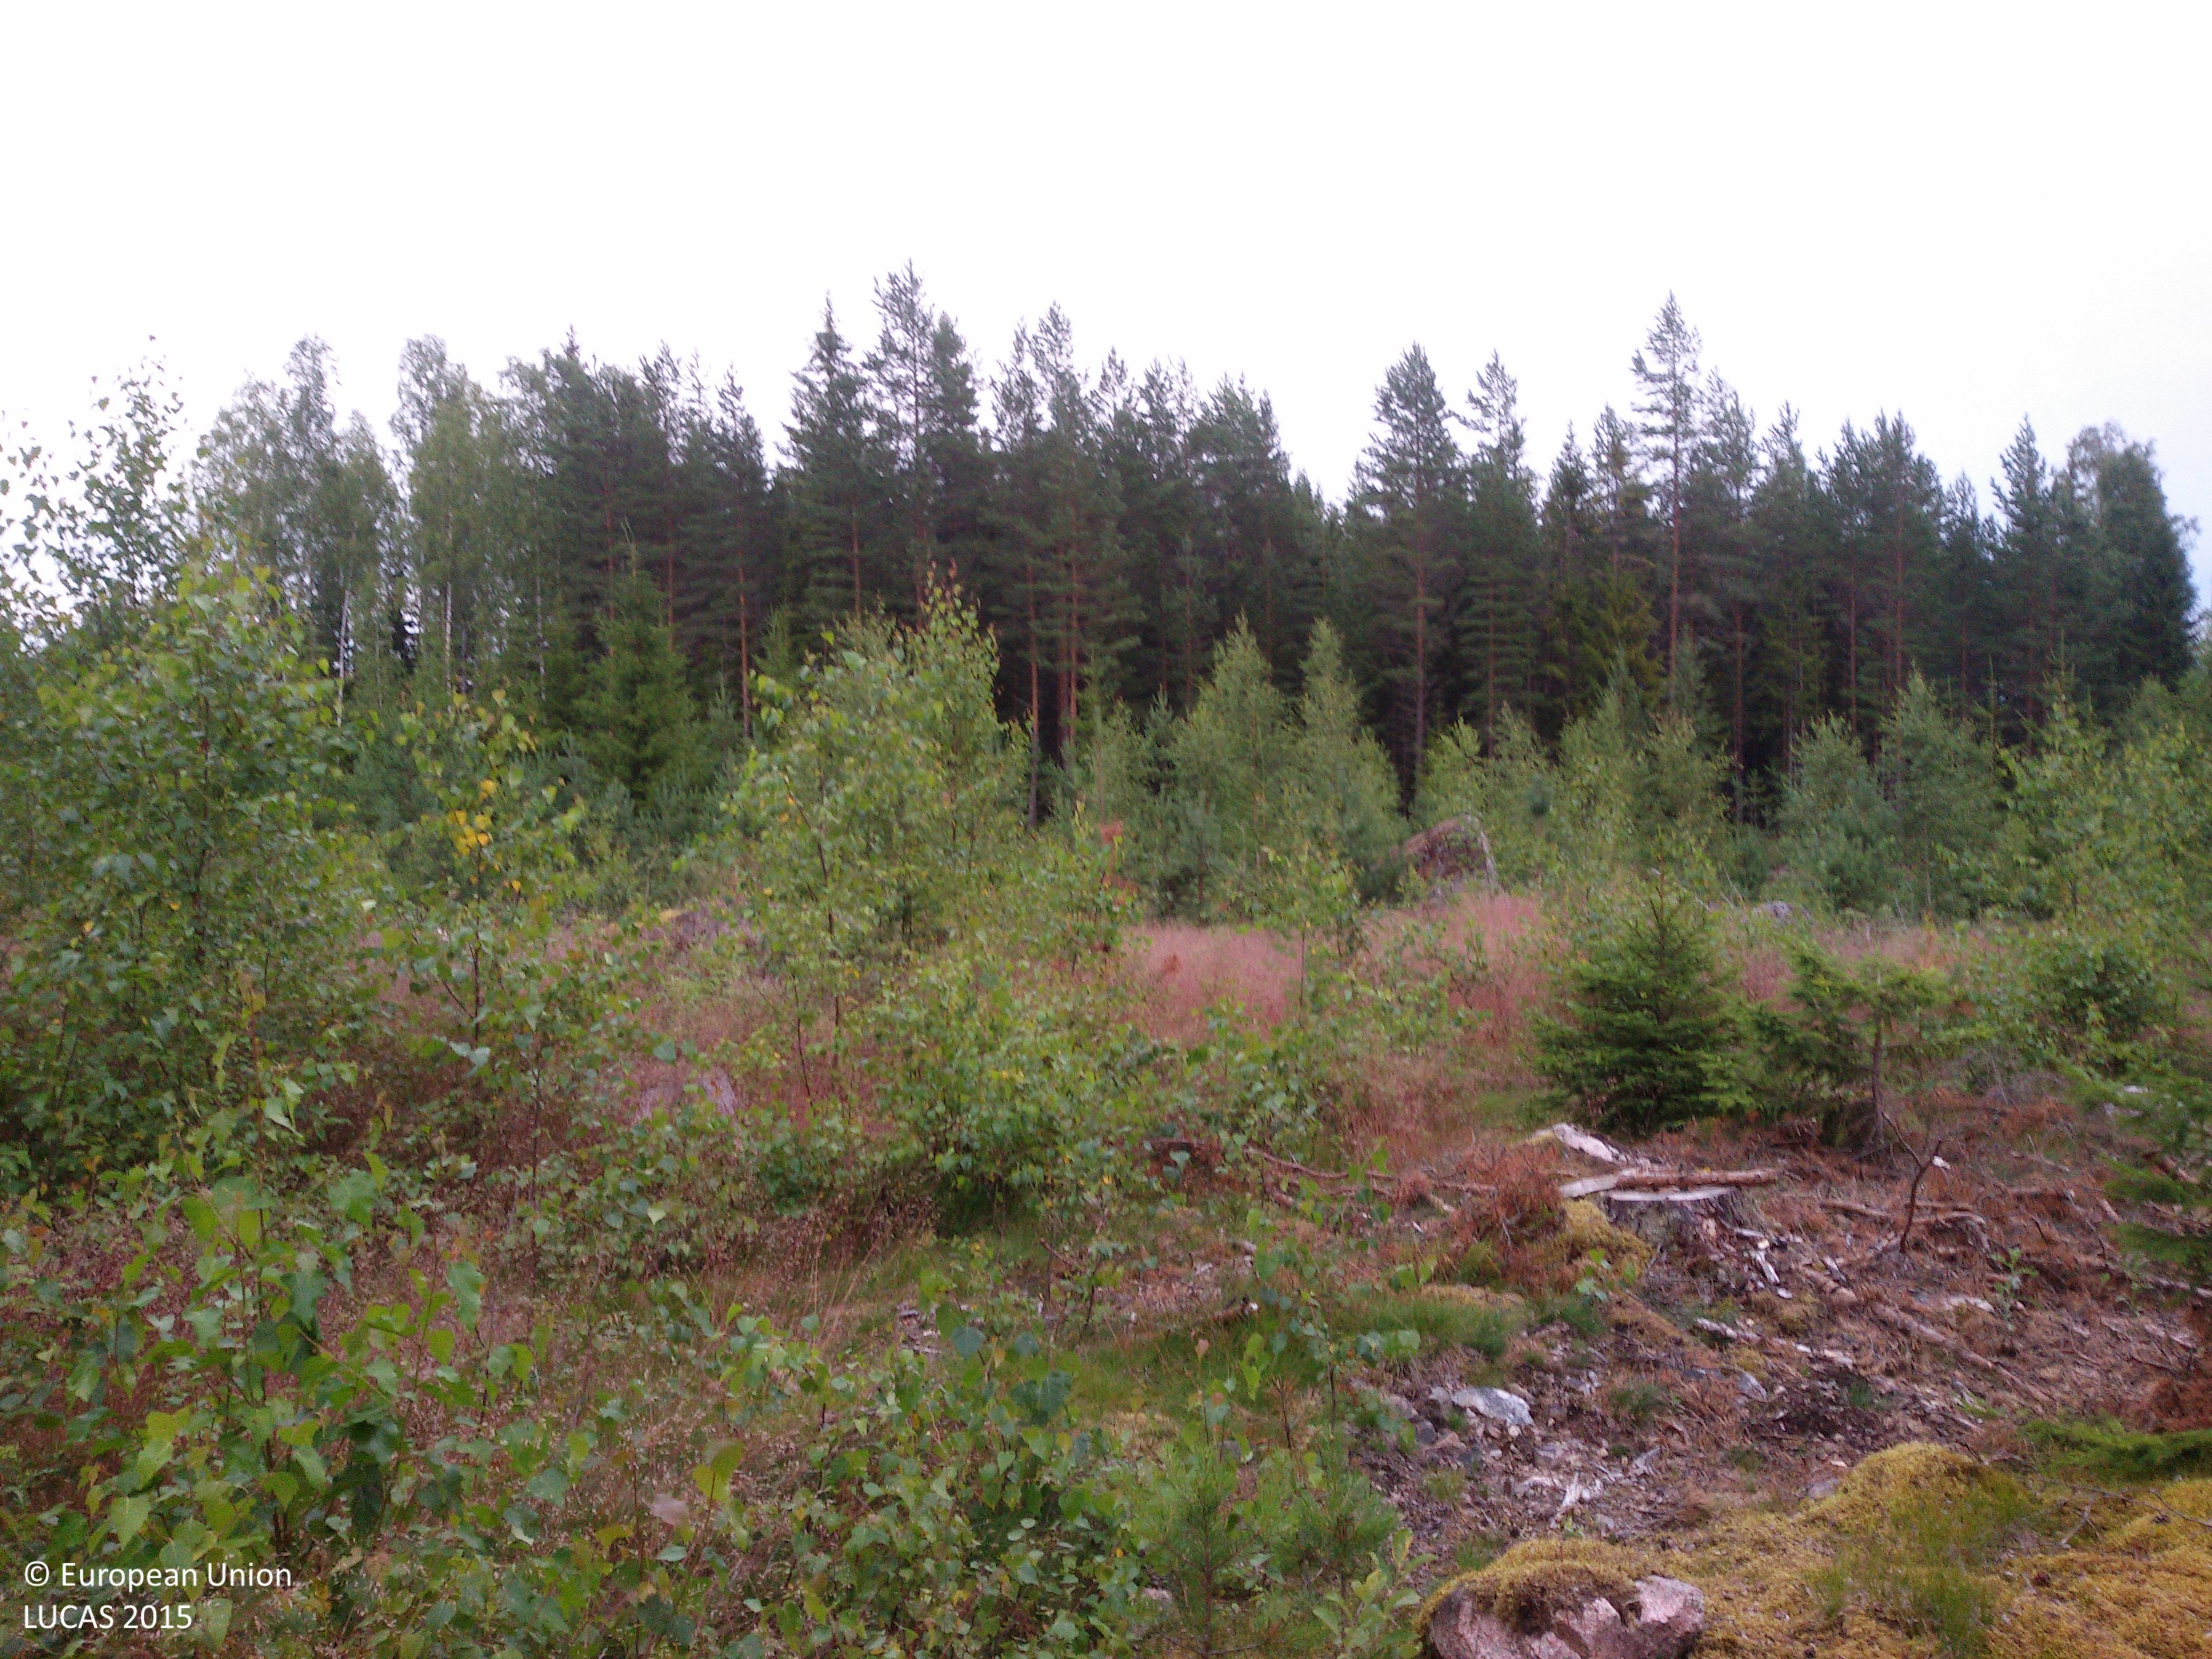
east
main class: Woodland
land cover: Spruce dominated mixed woodland
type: boreal forest
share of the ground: 50 - 75 %
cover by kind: coniferous forest trees 30 %, broadleaved forest trees 30 %, herbaceous plants 20 %, lichens and mosses 20 %
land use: Forestry
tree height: < 5 m
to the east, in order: Spruce dominated mixed woodland; Spontaneously vegetated surfaces; Spruce dominated mixed woodland; Pine dominated coniferous woodland; Spruce dominated mixed woodland
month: July
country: SE
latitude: 60.4383
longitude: 15.8573
